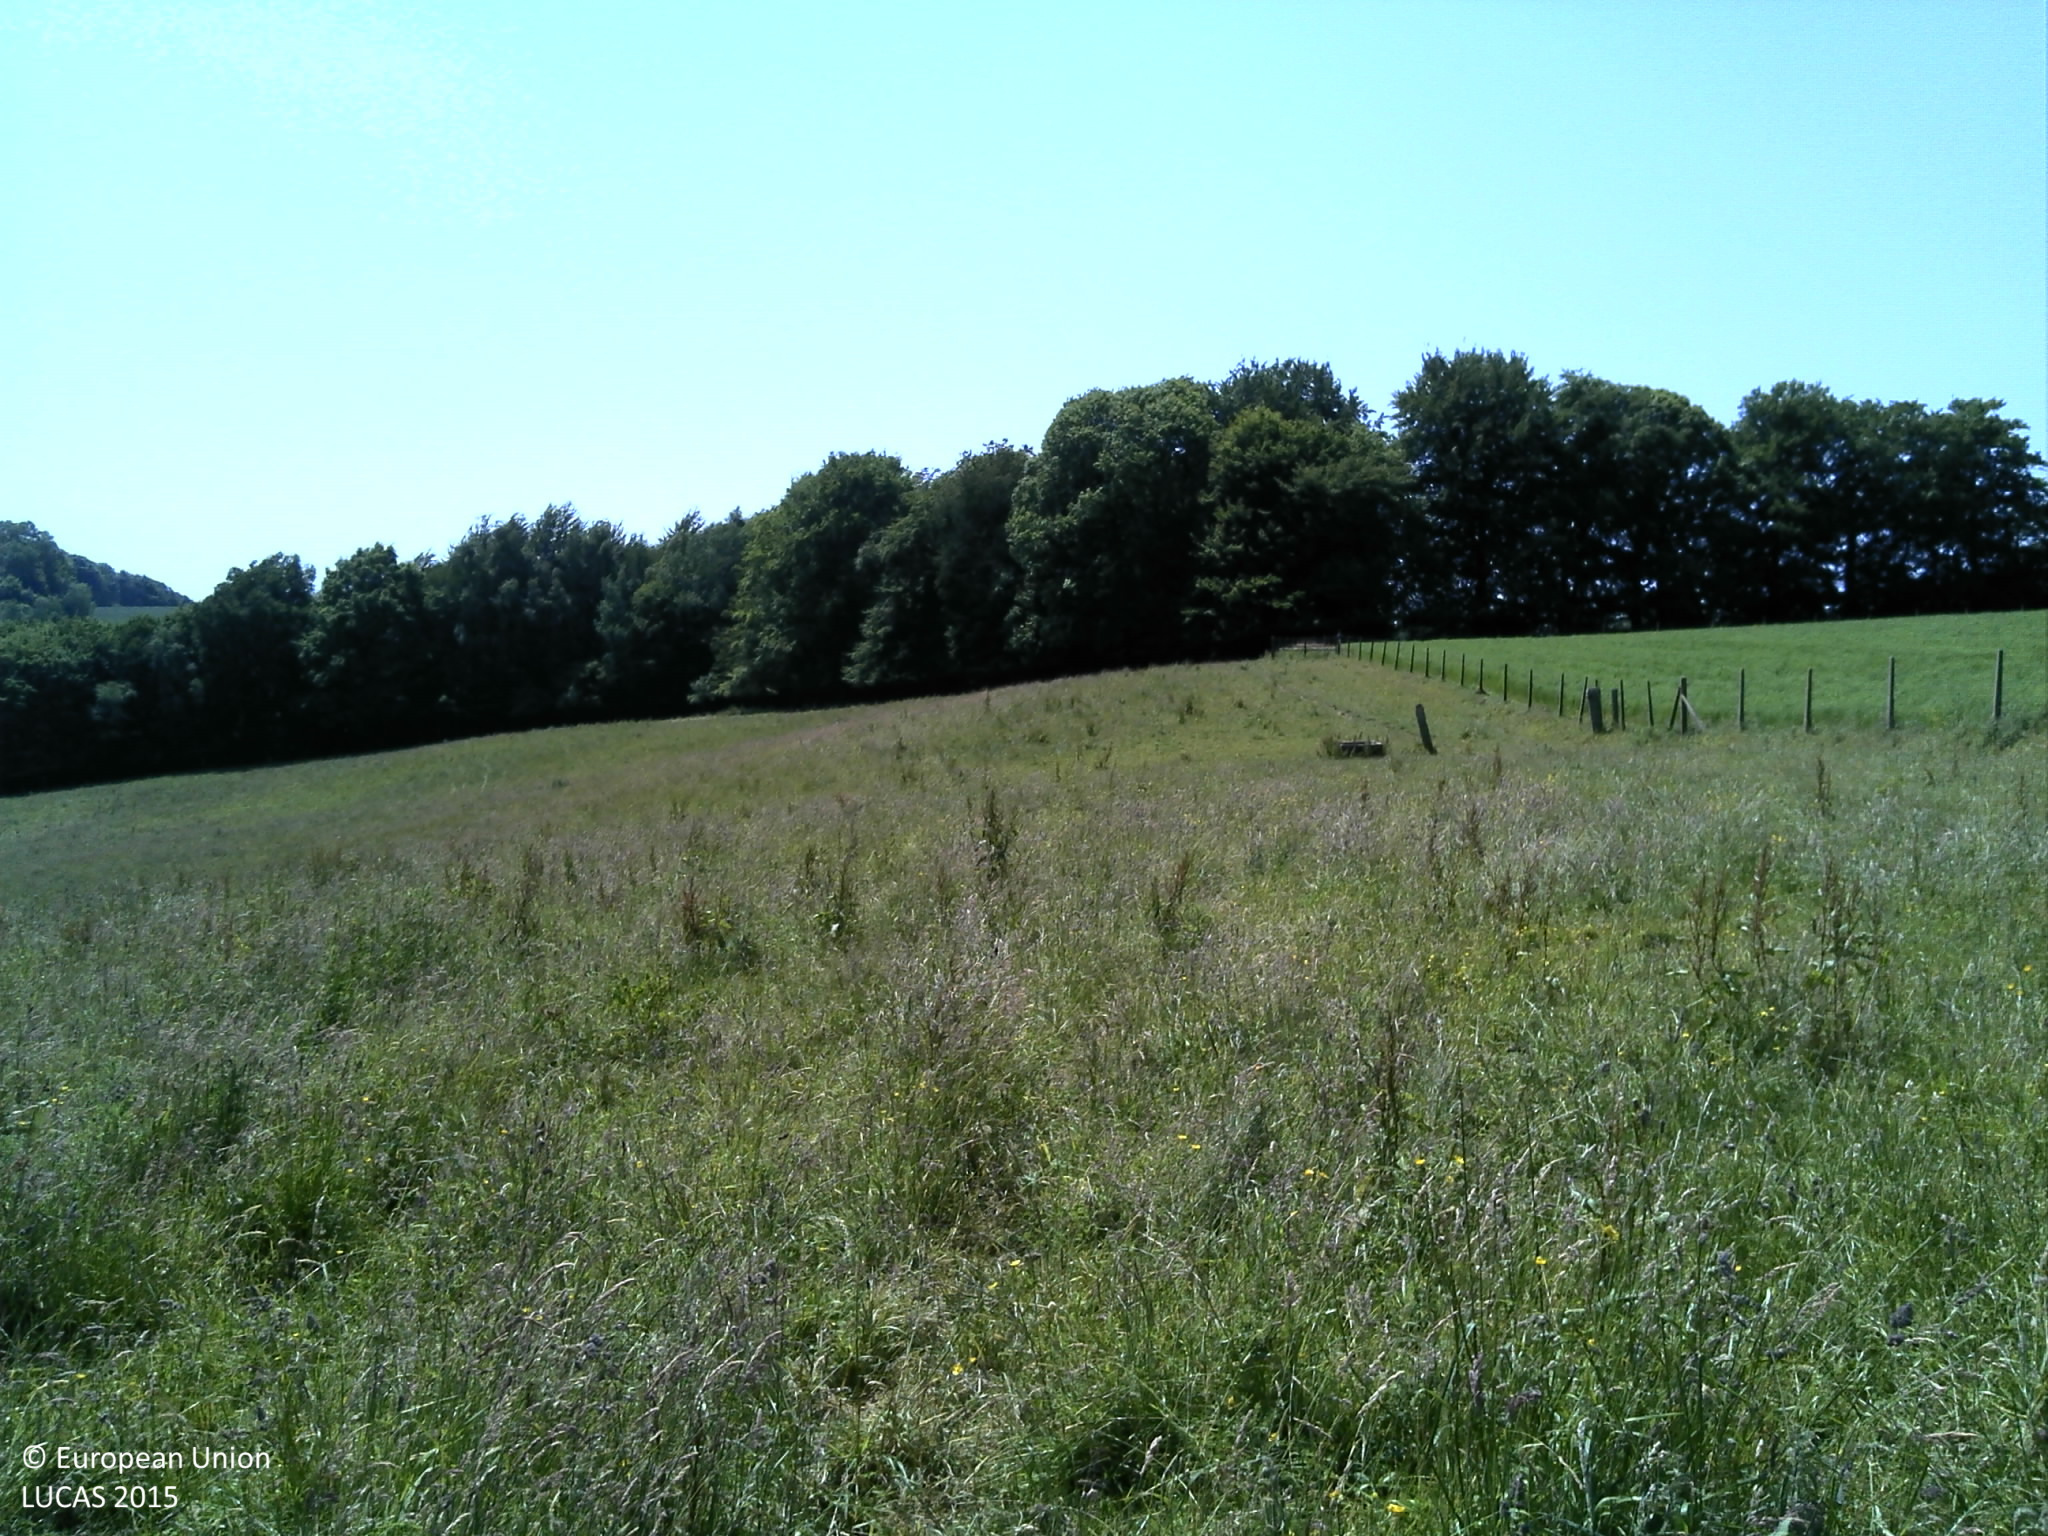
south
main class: Grassland
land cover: Grassland without tree/shrub cover
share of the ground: > 75 %
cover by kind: herbaceous plants 100 %
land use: Agriculture (excluding fallow land and kitchen gardens)
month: June
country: FR
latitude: 49.5498
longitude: 1.1465
